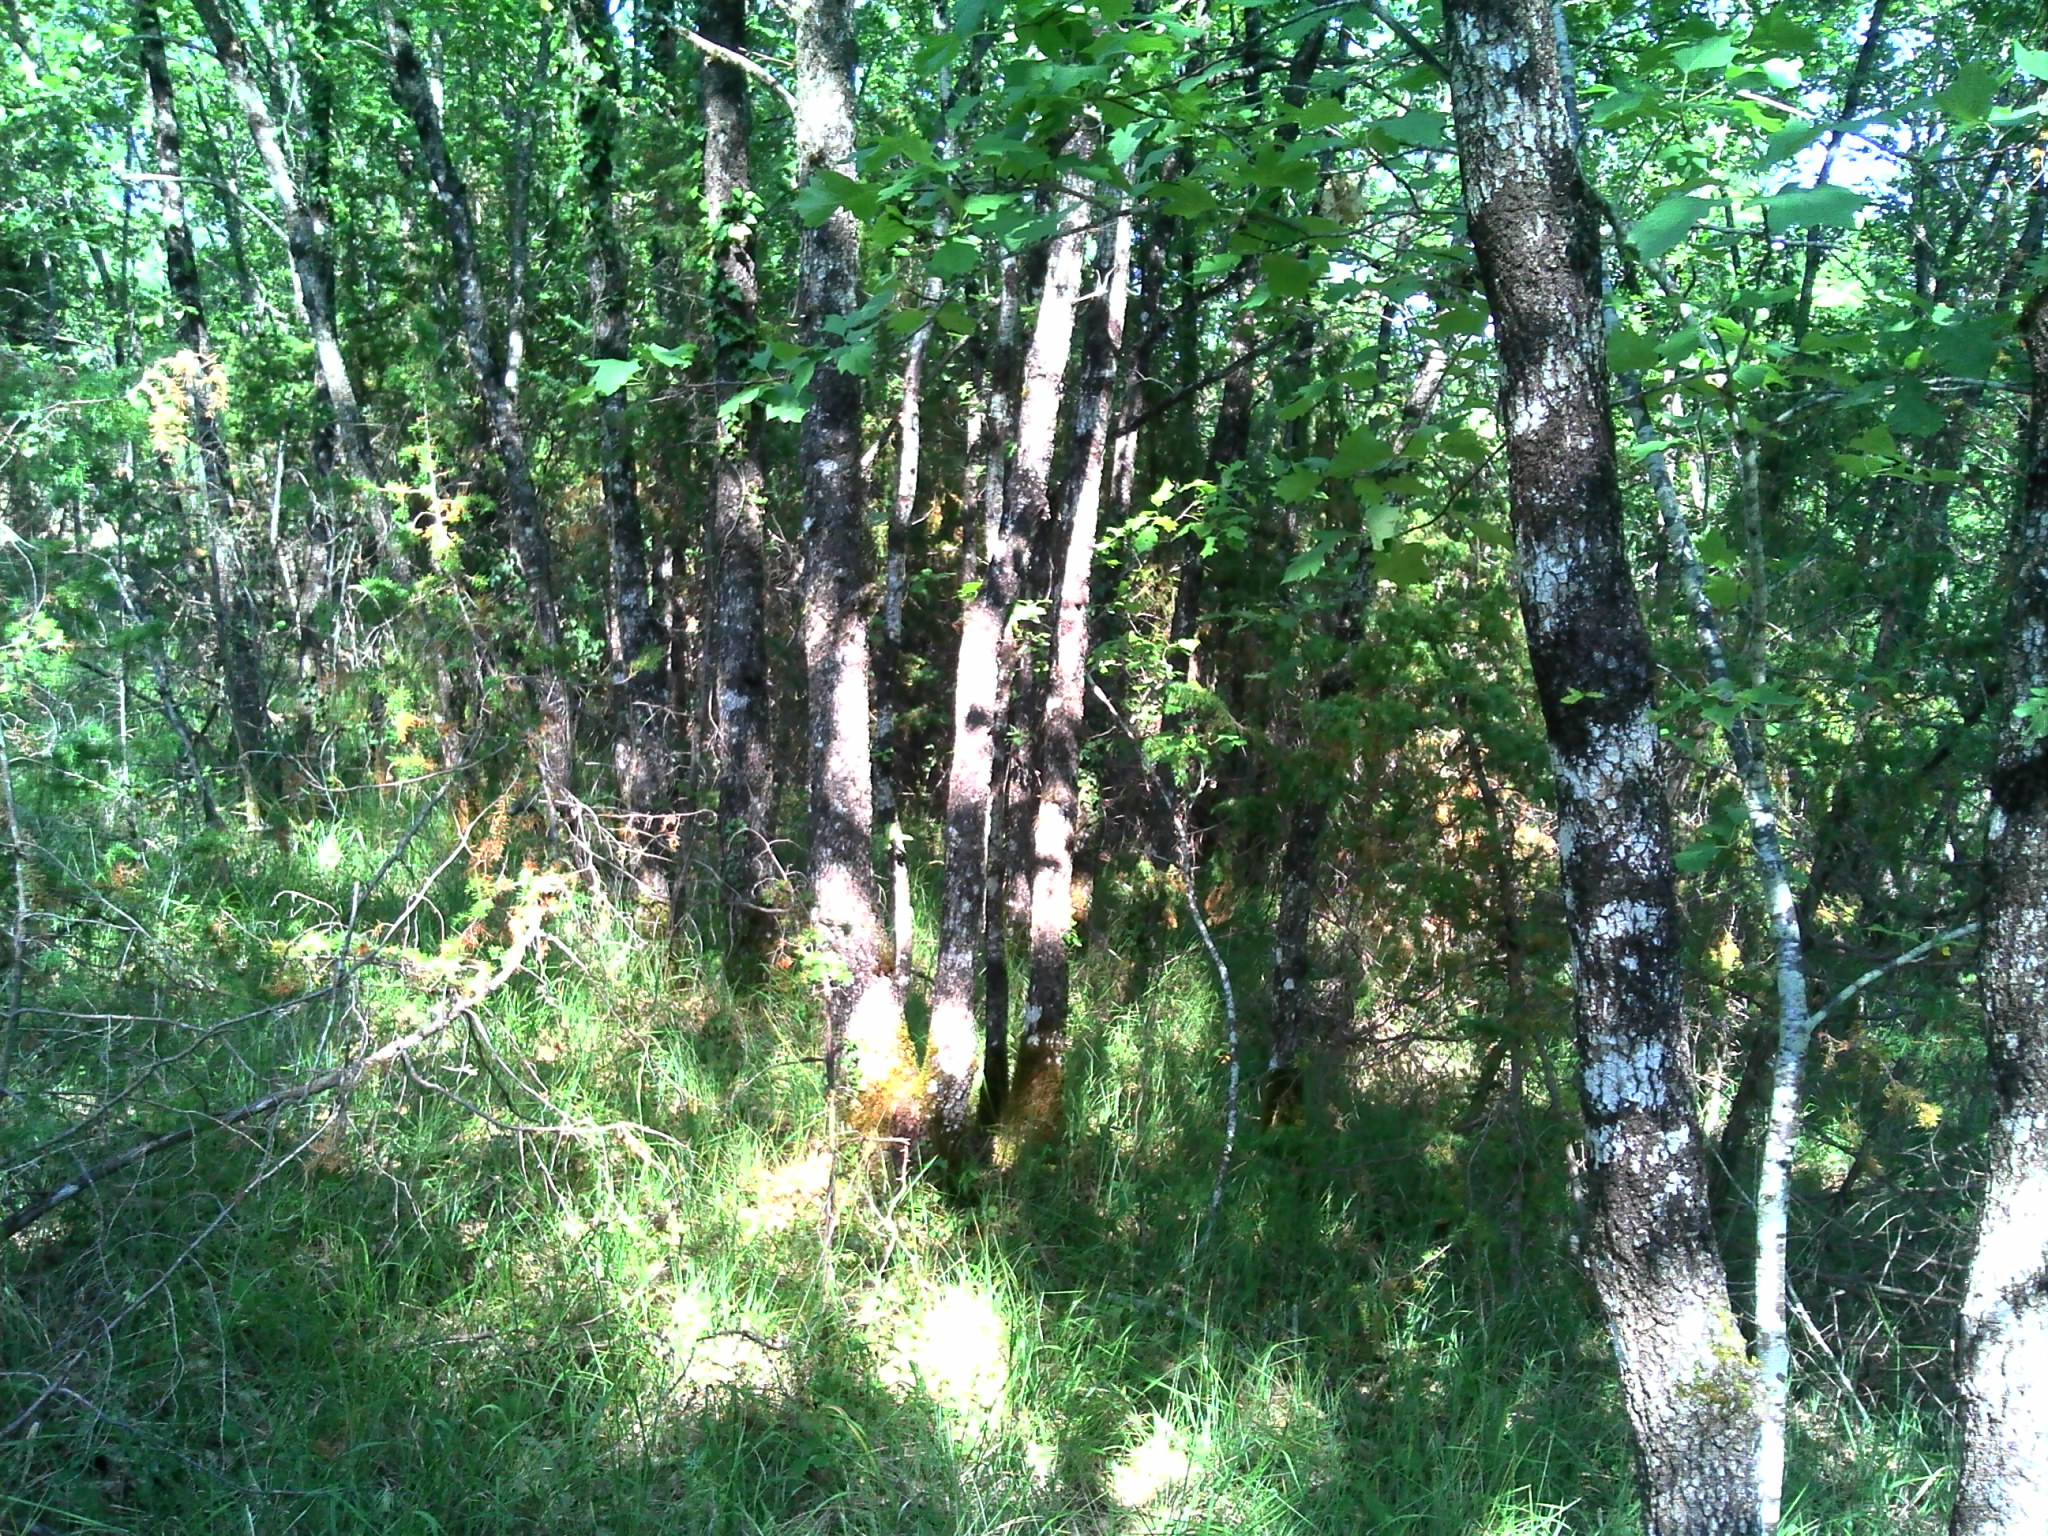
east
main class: Woodland
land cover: Broadleaved woodland
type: thermophilous deciduous forest
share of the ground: > 75 %
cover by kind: broadleaved forest trees 95 %, herbaceous plants 5 %
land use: Forestry
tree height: > 5 m
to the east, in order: Broadleaved woodland; Spontaneously vegetated surfaces; Grassland without tree/shrub cover; Broadleaved woodland; Grassland without tree/shrub cover; Broadleaved woodland
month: June
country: FR
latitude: 44.9748
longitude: 1.4364
